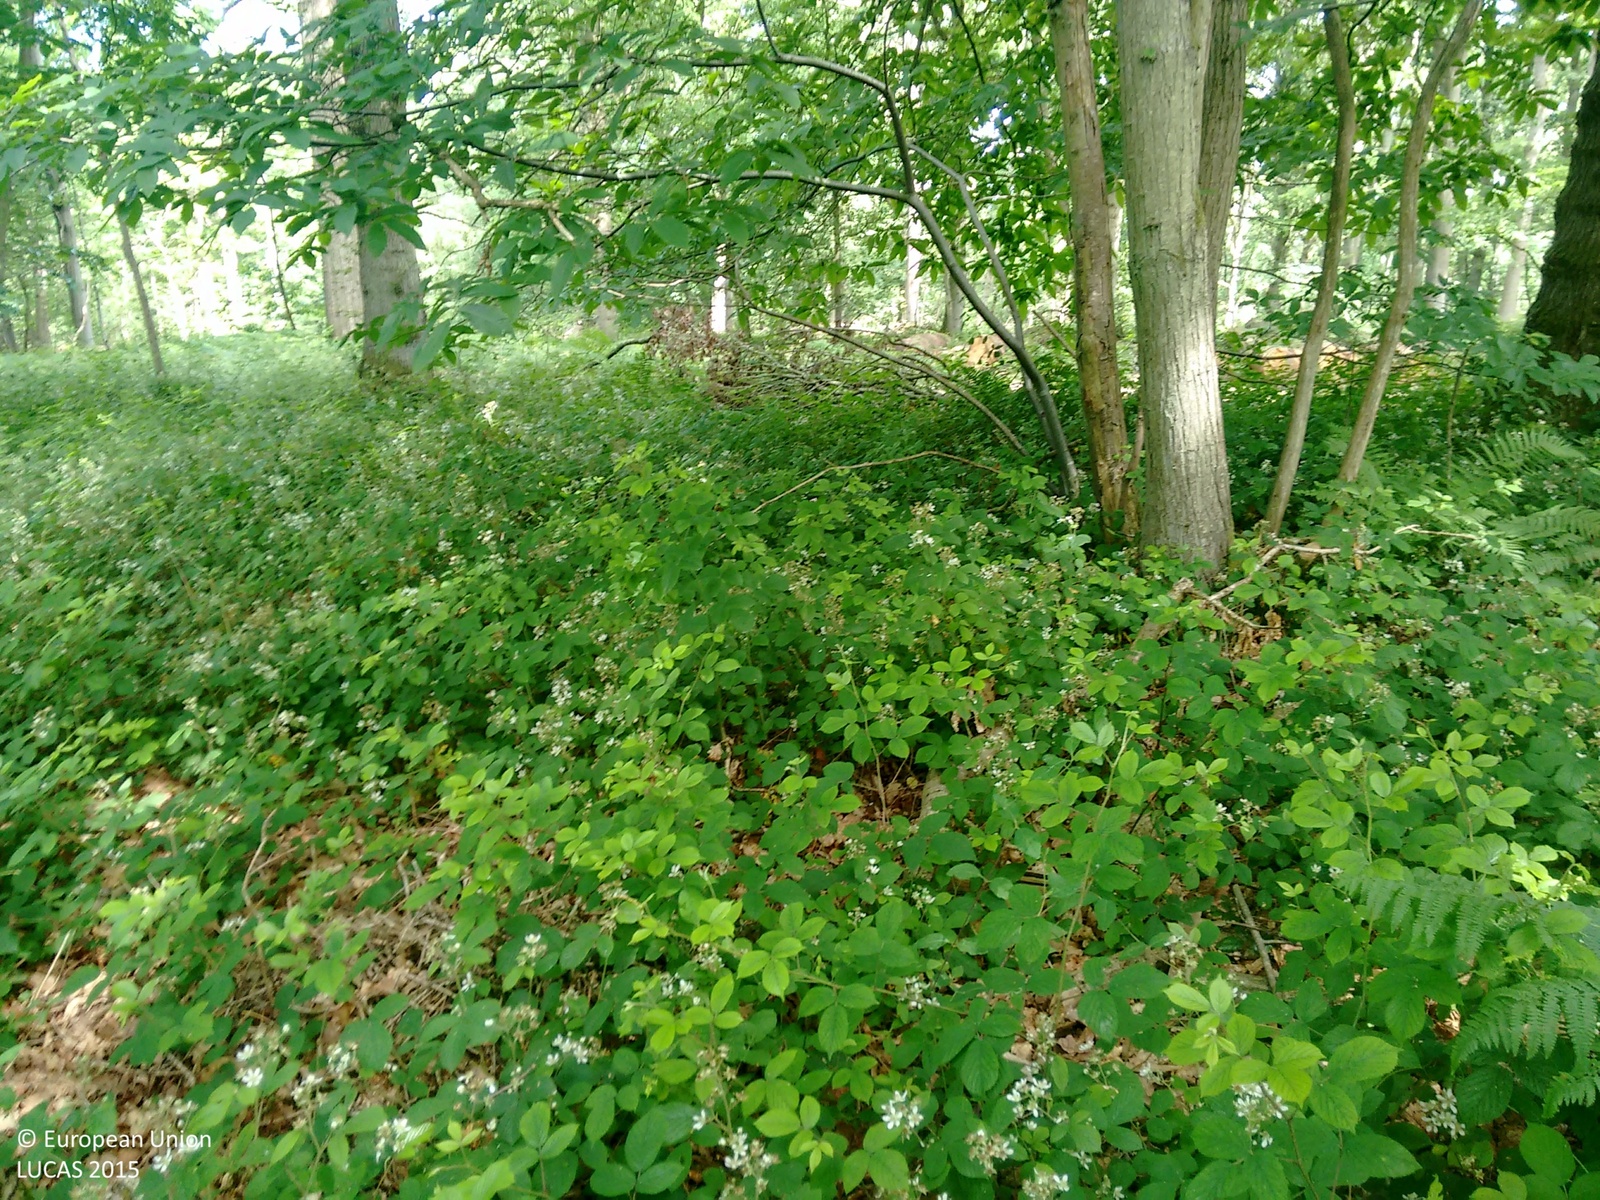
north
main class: Woodland
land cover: Broadleaved woodland
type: mesophytic deciduous forest
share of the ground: > 75 %
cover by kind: broadleaved forest trees 95 %, shrubs 5 %
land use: Semi-natural and natural areas not in use
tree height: > 5 m
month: July
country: GB
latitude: 52.1636
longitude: -2.7157
